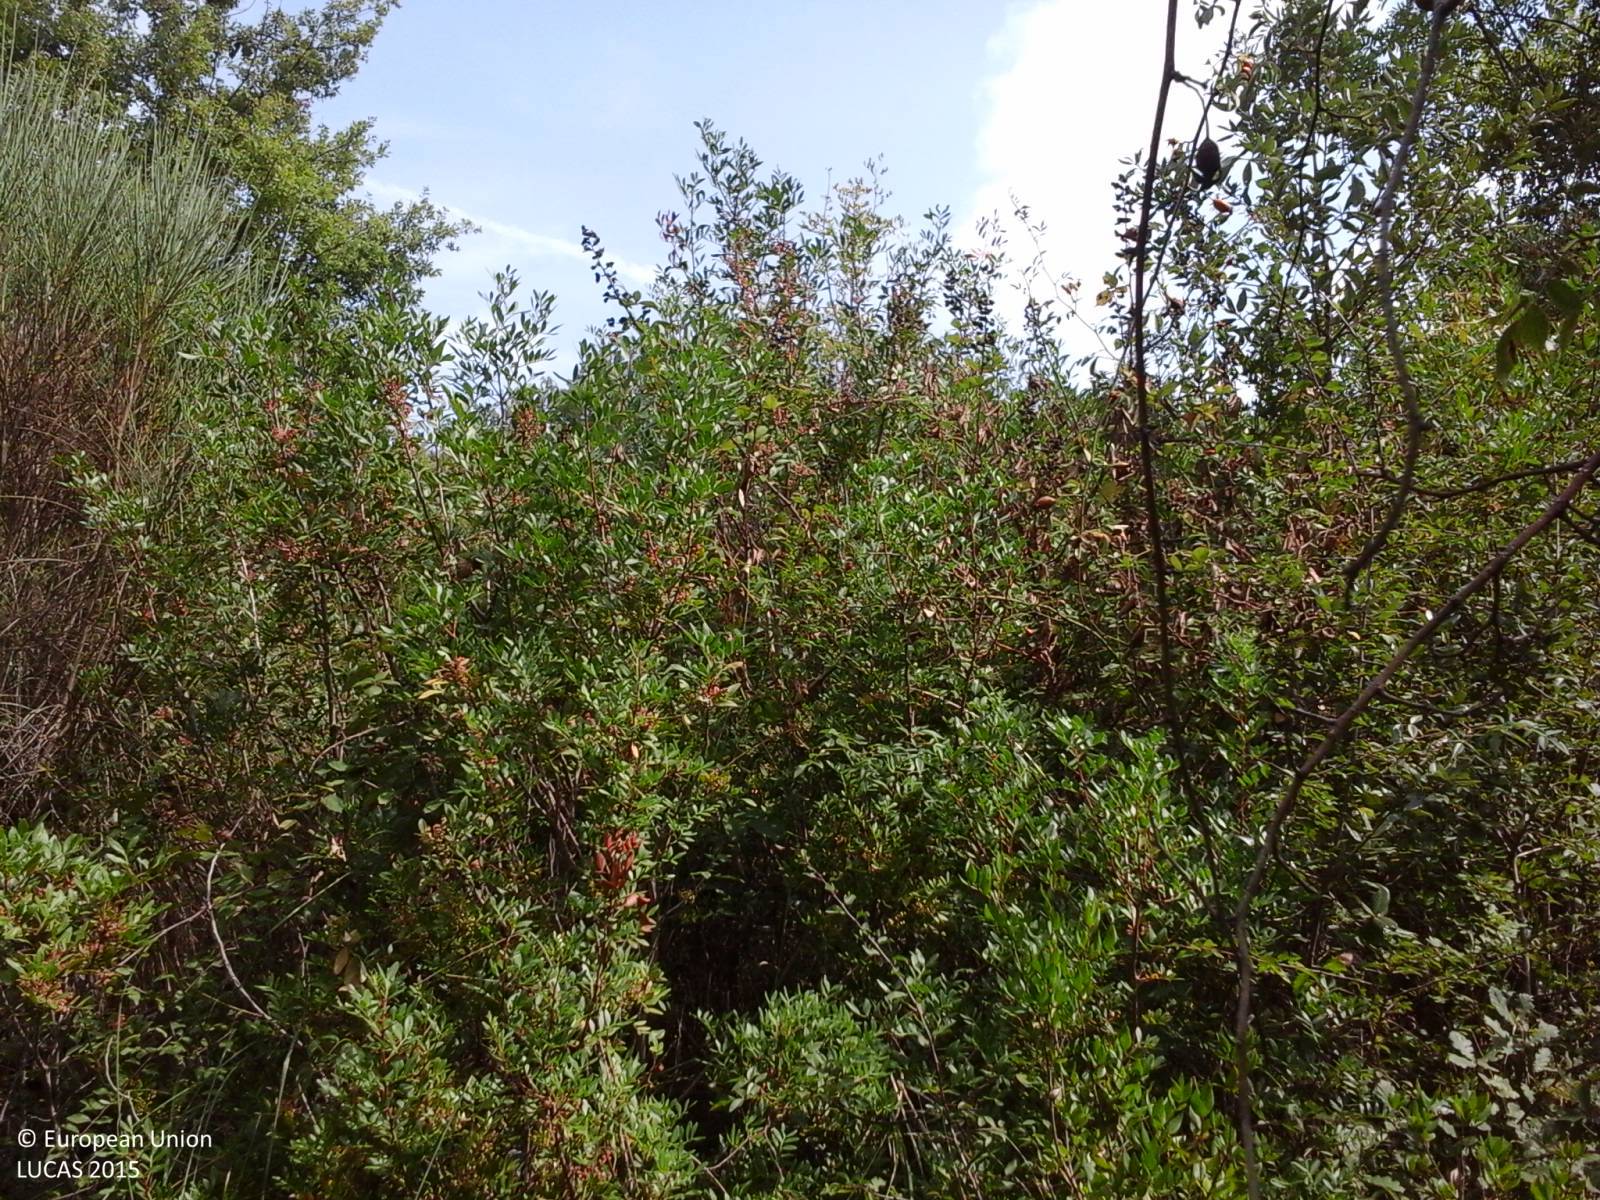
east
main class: Woodland
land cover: Broadleaved woodland
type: thermophilous deciduous forest
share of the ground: > 75 %
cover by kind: broadleaved forest trees 90 %, herbaceous plants 10 %
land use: Forestry
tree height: < 5 m
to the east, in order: Broadleaved woodland; Grassland without tree/shrub cover; Abandoned hedges; Fences; Grassland without tree/shrub cover; Fences; Rocks and stones; Broadleaved woodland
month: September
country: IT
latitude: 41.3203
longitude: 13.7008
